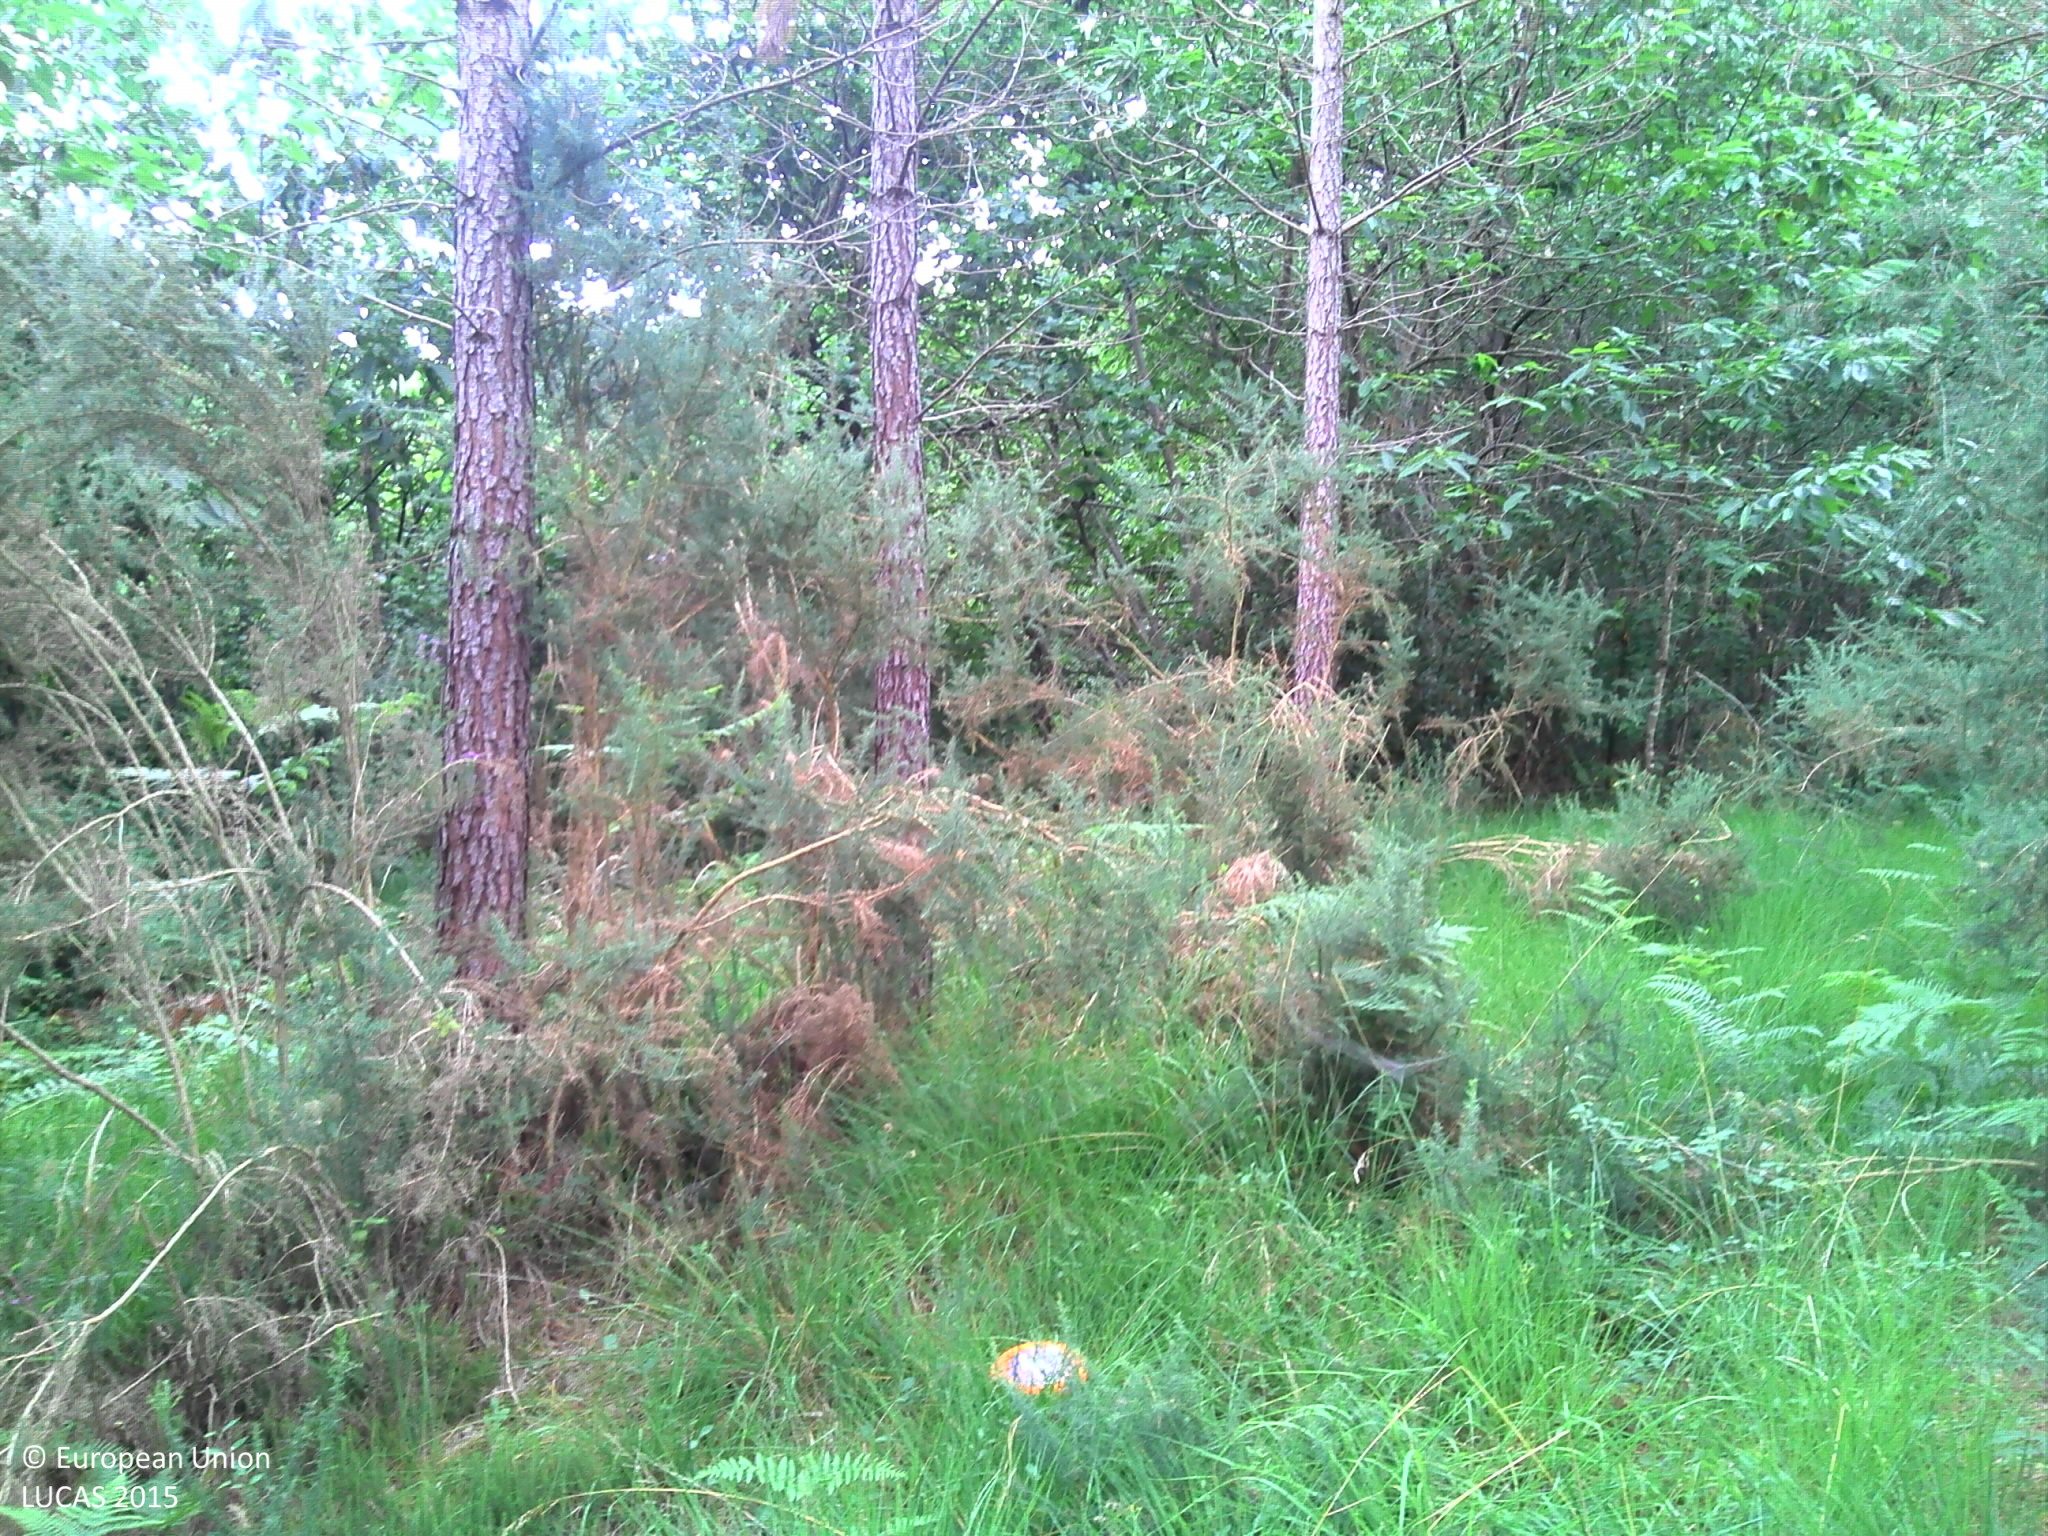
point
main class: Woodland
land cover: Pine dominated coniferous woodland
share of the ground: > 75 %
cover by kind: coniferous forest trees 85 %, herbaceous plants 10 %, broadleaved forest trees 5 %
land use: Forestry
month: July
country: FR
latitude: 43.5911
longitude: -1.2510
